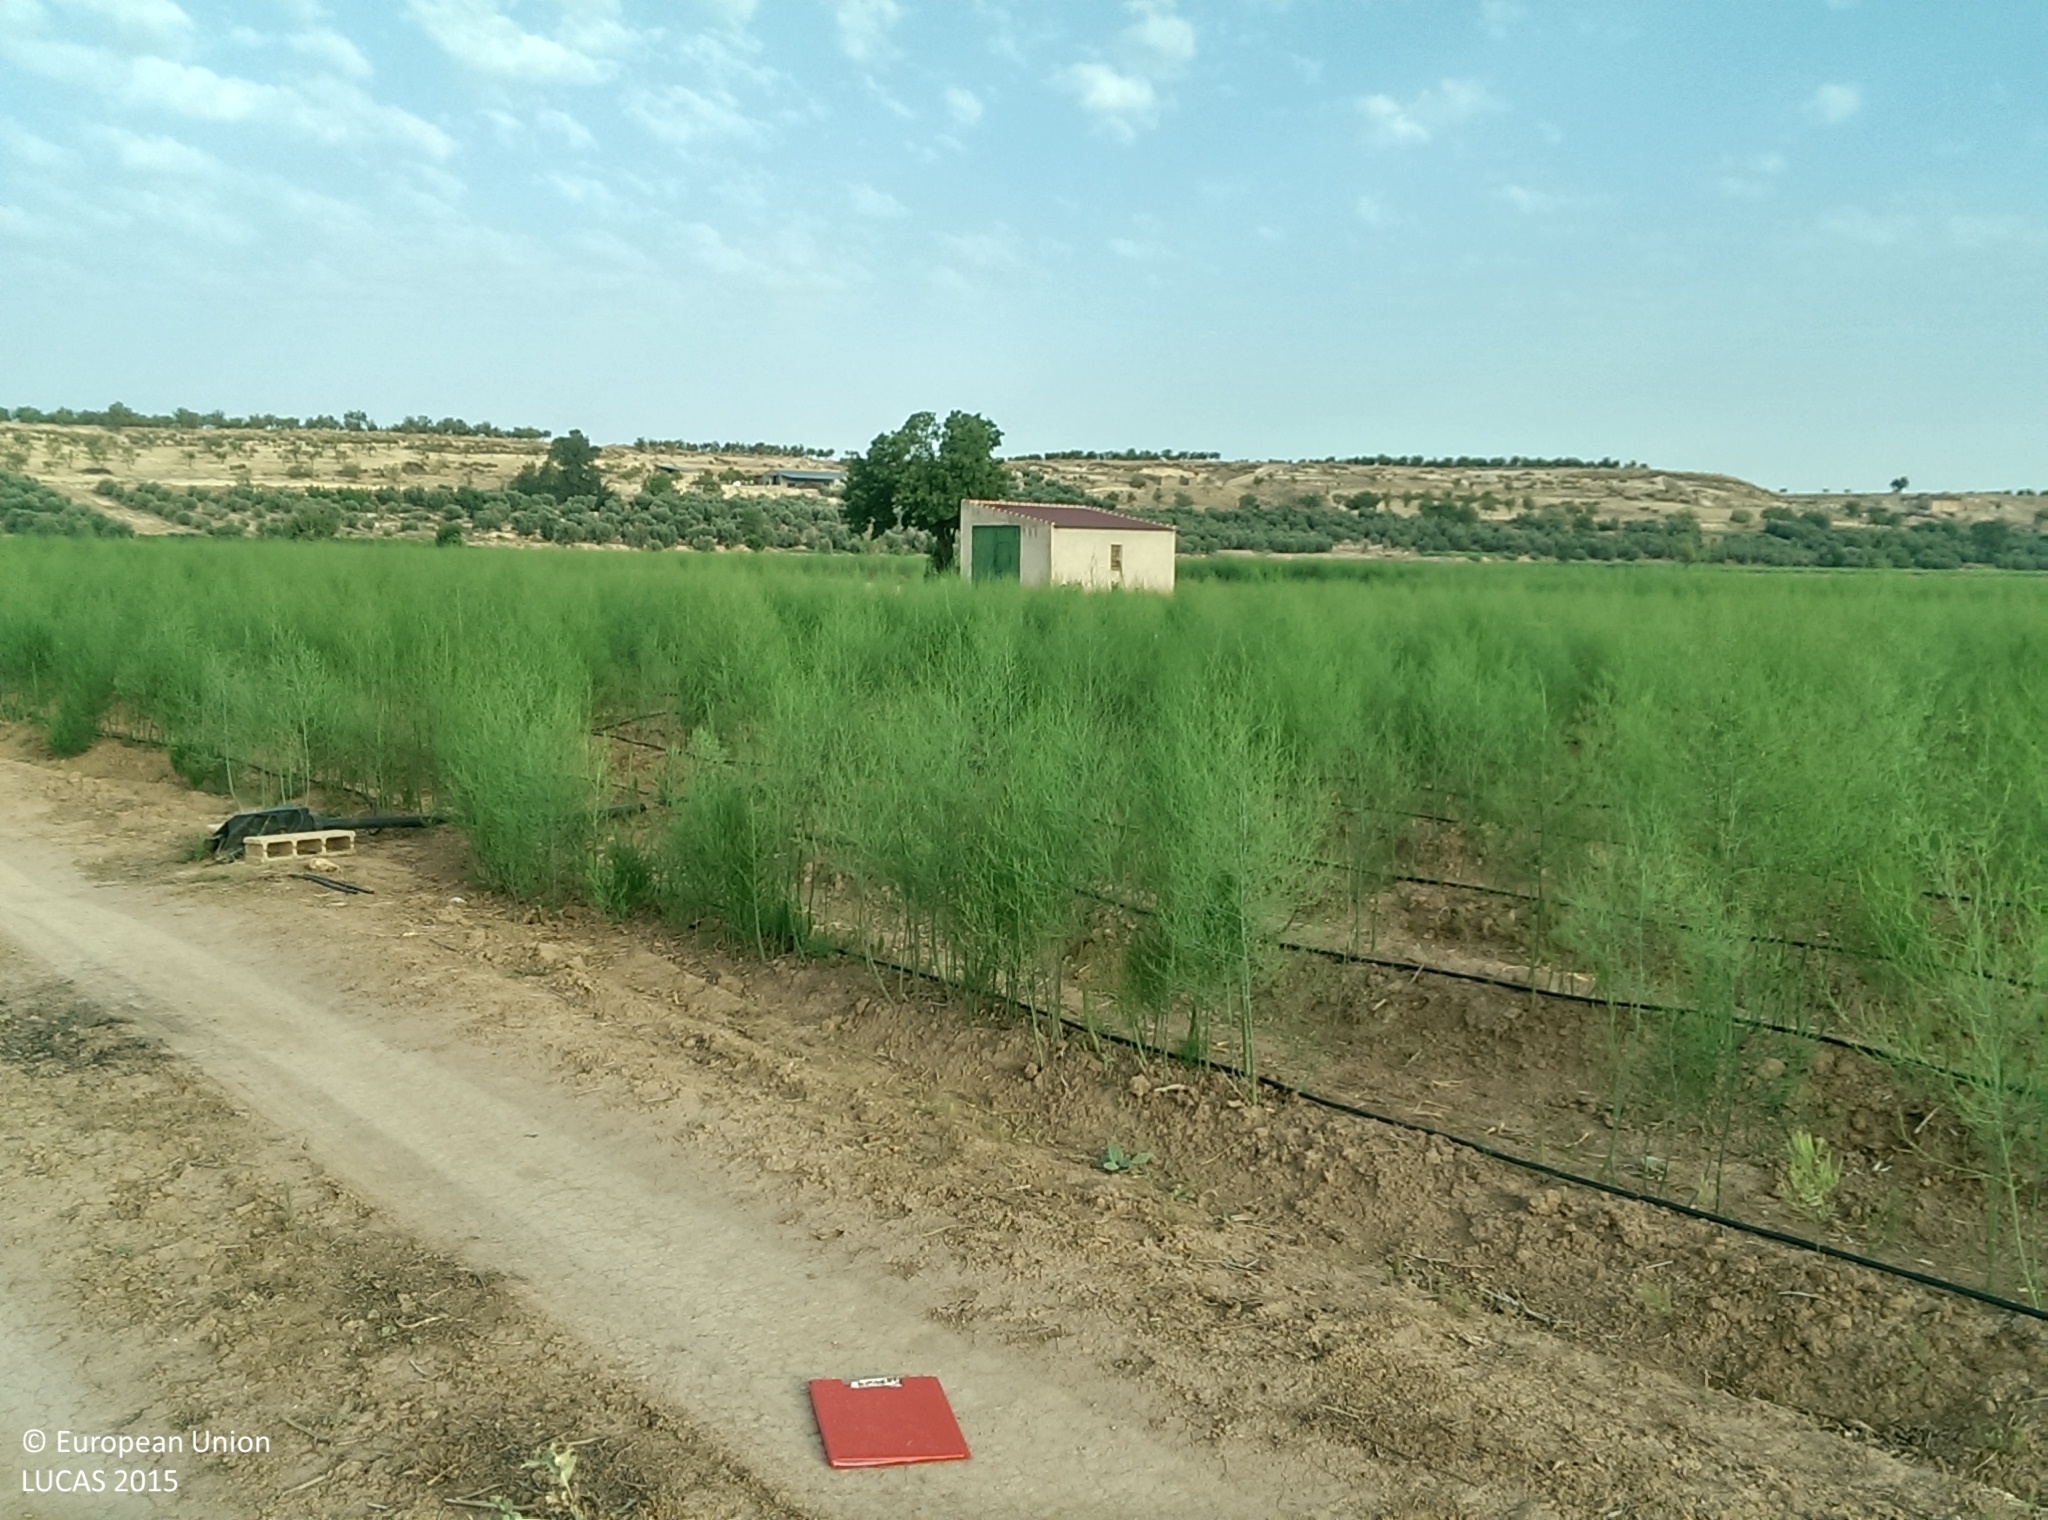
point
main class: Cropland
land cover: Other fresh vegetables
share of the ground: > 75 %
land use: Agriculture (excluding fallow land and kitchen gardens)
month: July
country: ES
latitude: 37.6294
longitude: -2.9419
